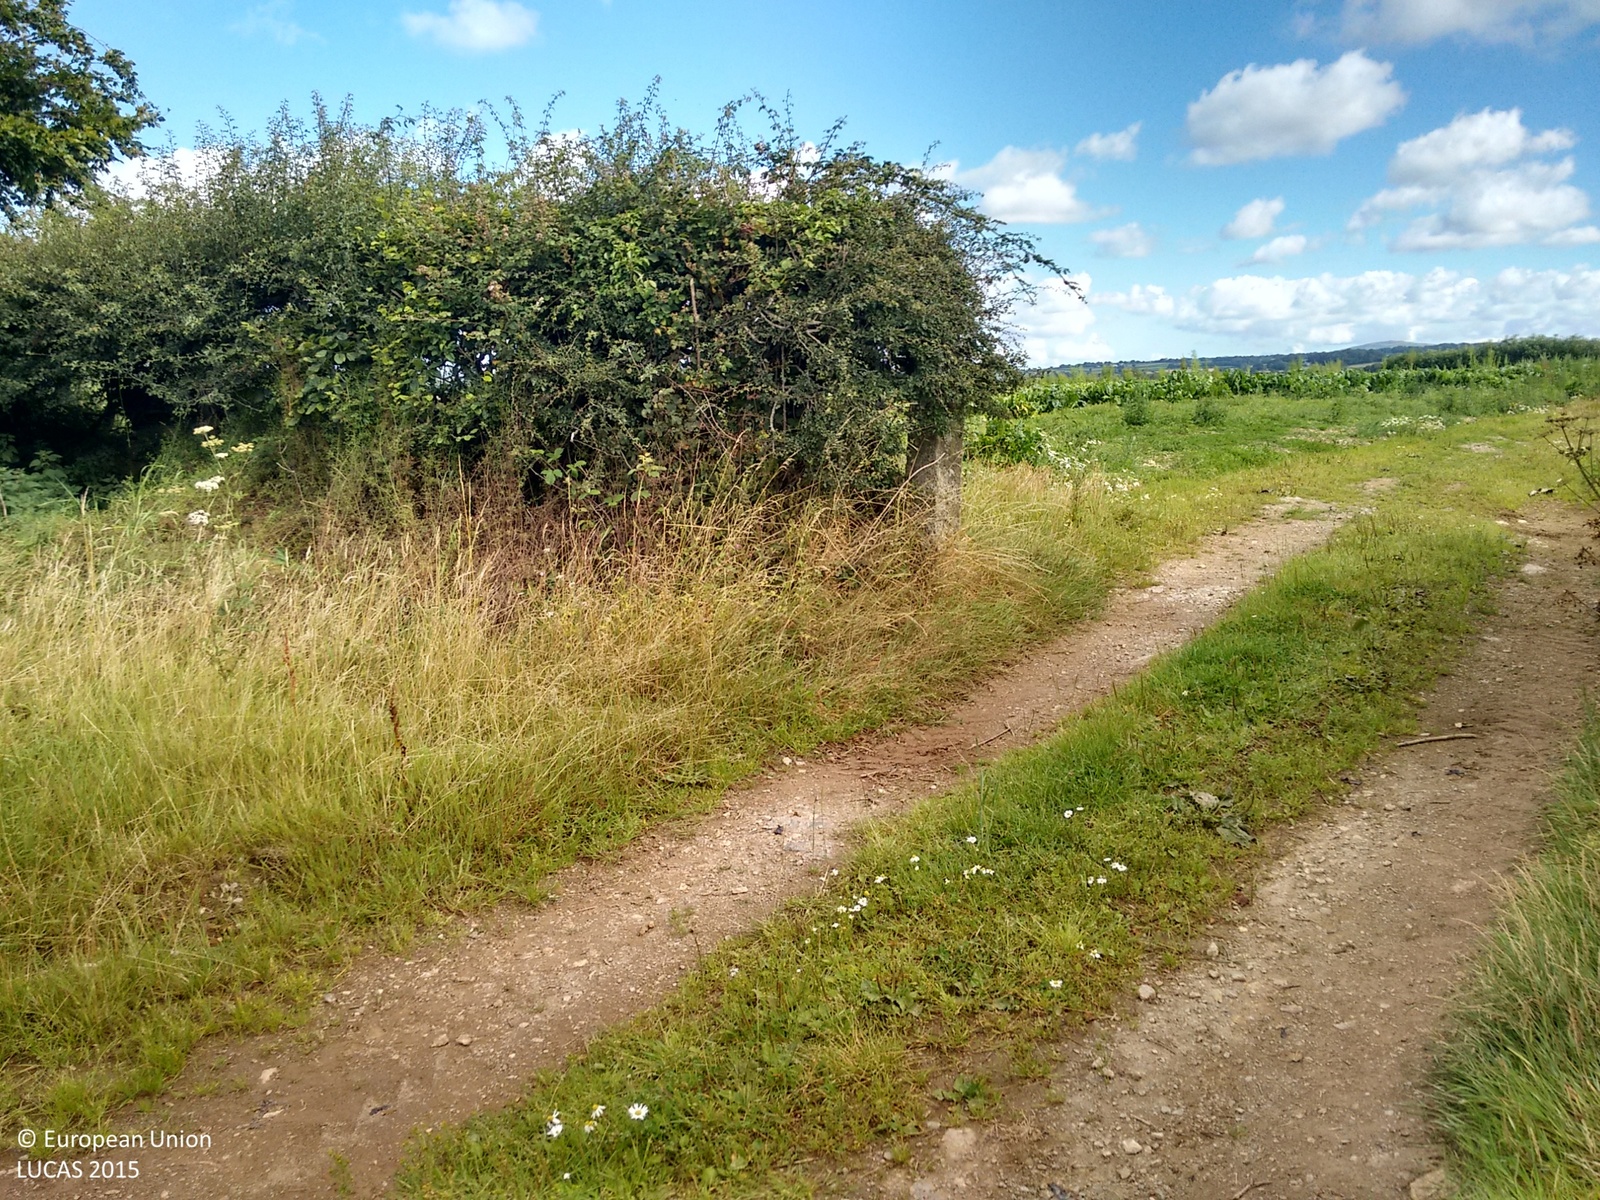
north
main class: Cropland
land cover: Sugar beet
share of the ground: > 75 %
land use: Agriculture (excluding fallow land and kitchen gardens)
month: August
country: GB
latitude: 50.4657
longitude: -4.1424
